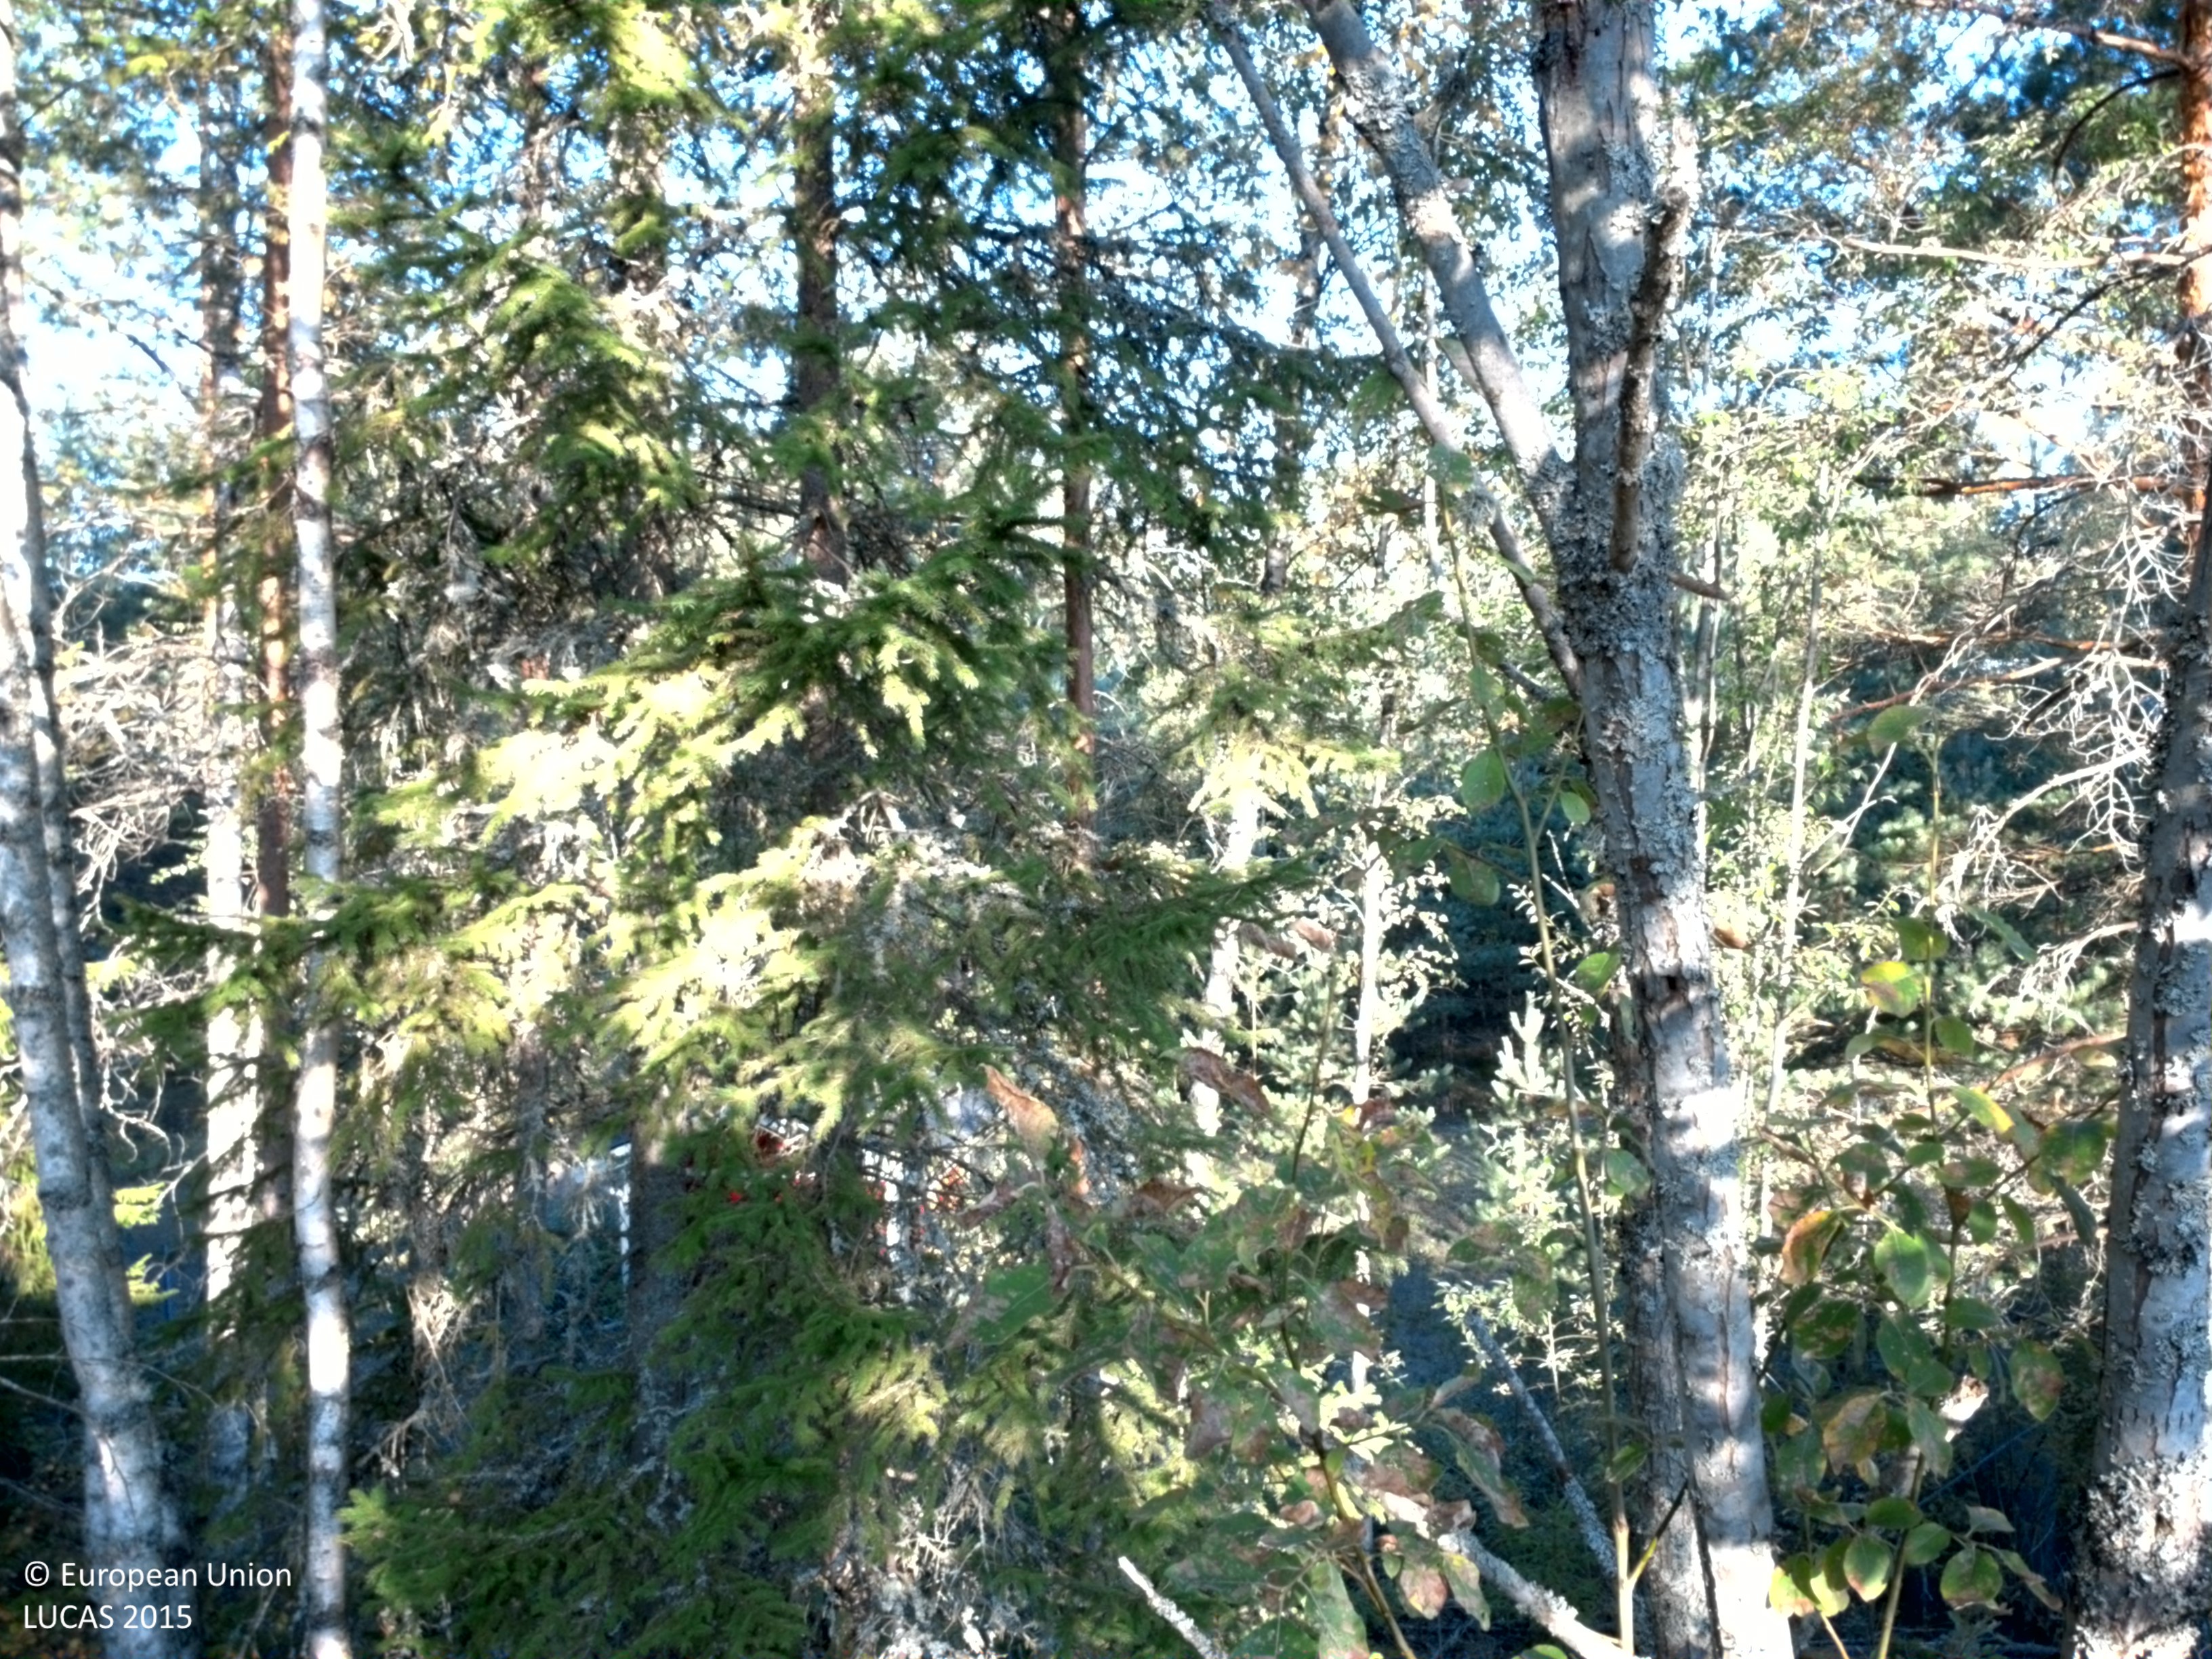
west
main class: Woodland
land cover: Pine dominated mixed woodland
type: boreal forest
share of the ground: 25 - 50 %
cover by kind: coniferous forest trees 35 %, lichens and mosses 25 %, consolidated bare surface 20 %, broadleaved forest trees 15 %, herbaceous plants 5 %
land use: Sport
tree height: > 5 m
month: August
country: SE
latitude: 59.5288
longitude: 13.3335
